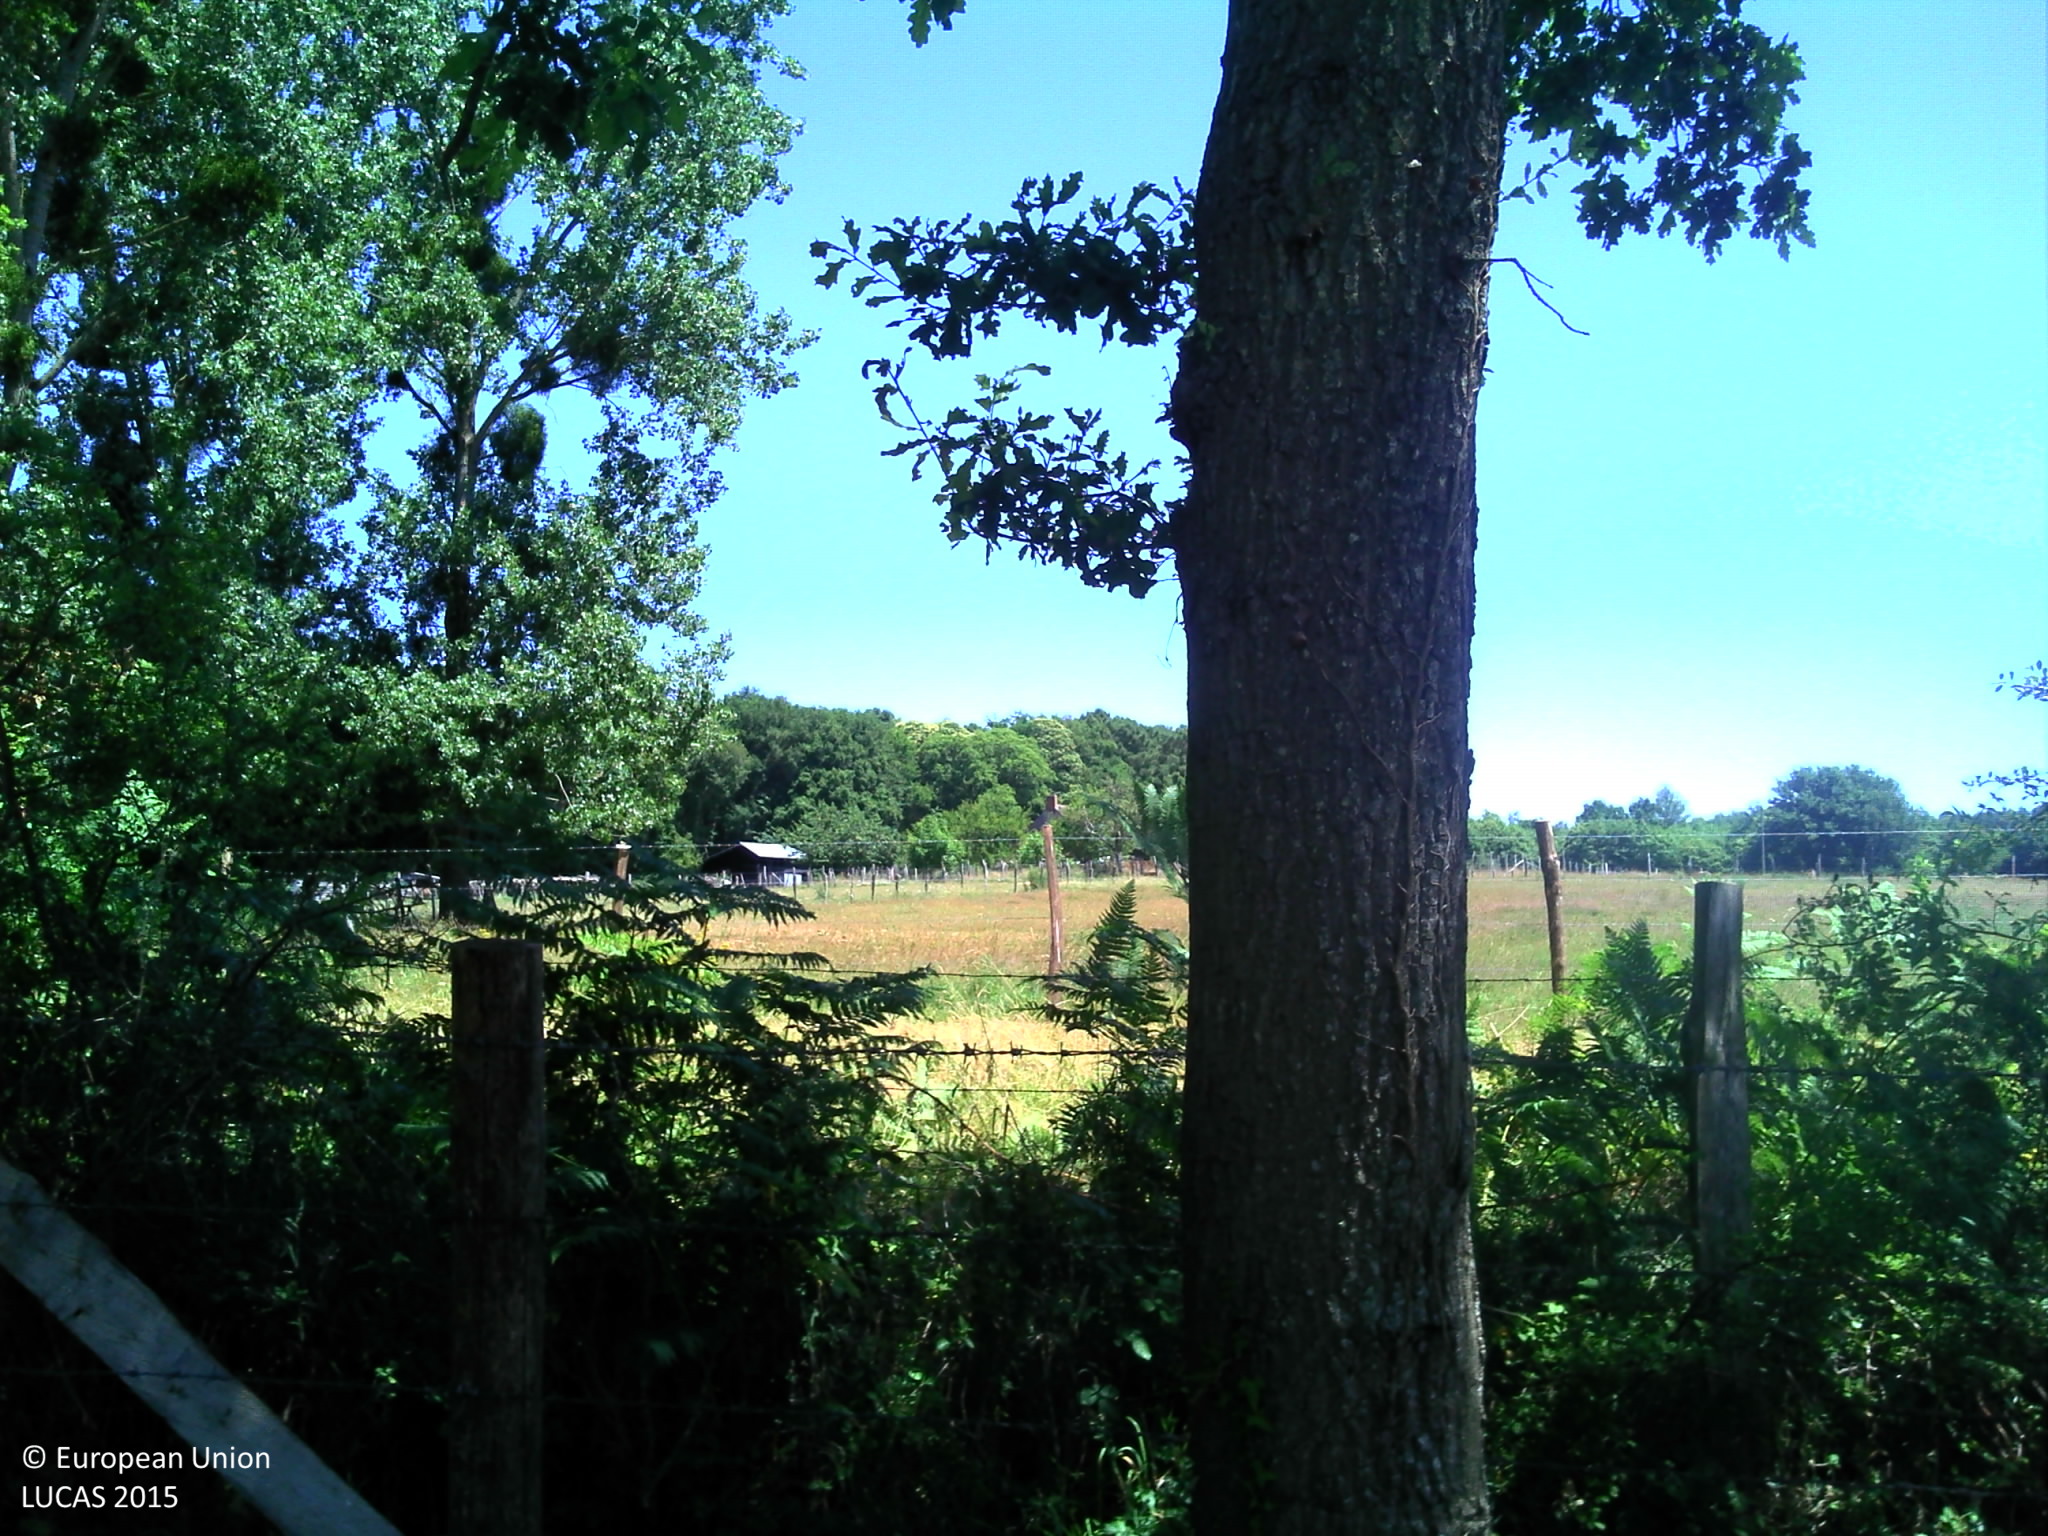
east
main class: Grassland
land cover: Grassland without tree/shrub cover
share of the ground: > 75 %
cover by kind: herbaceous plants 100 %
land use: Agriculture (excluding fallow land and kitchen gardens)
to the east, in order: Grassland without tree/shrub cover; Fences; Inland fresh water bodies; Fences; Grassland without tree/shrub cover; Abandoned hedges; Fences; Grassland without tree/shrub cover
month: June
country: FR
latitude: 47.9573
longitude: 0.2929
